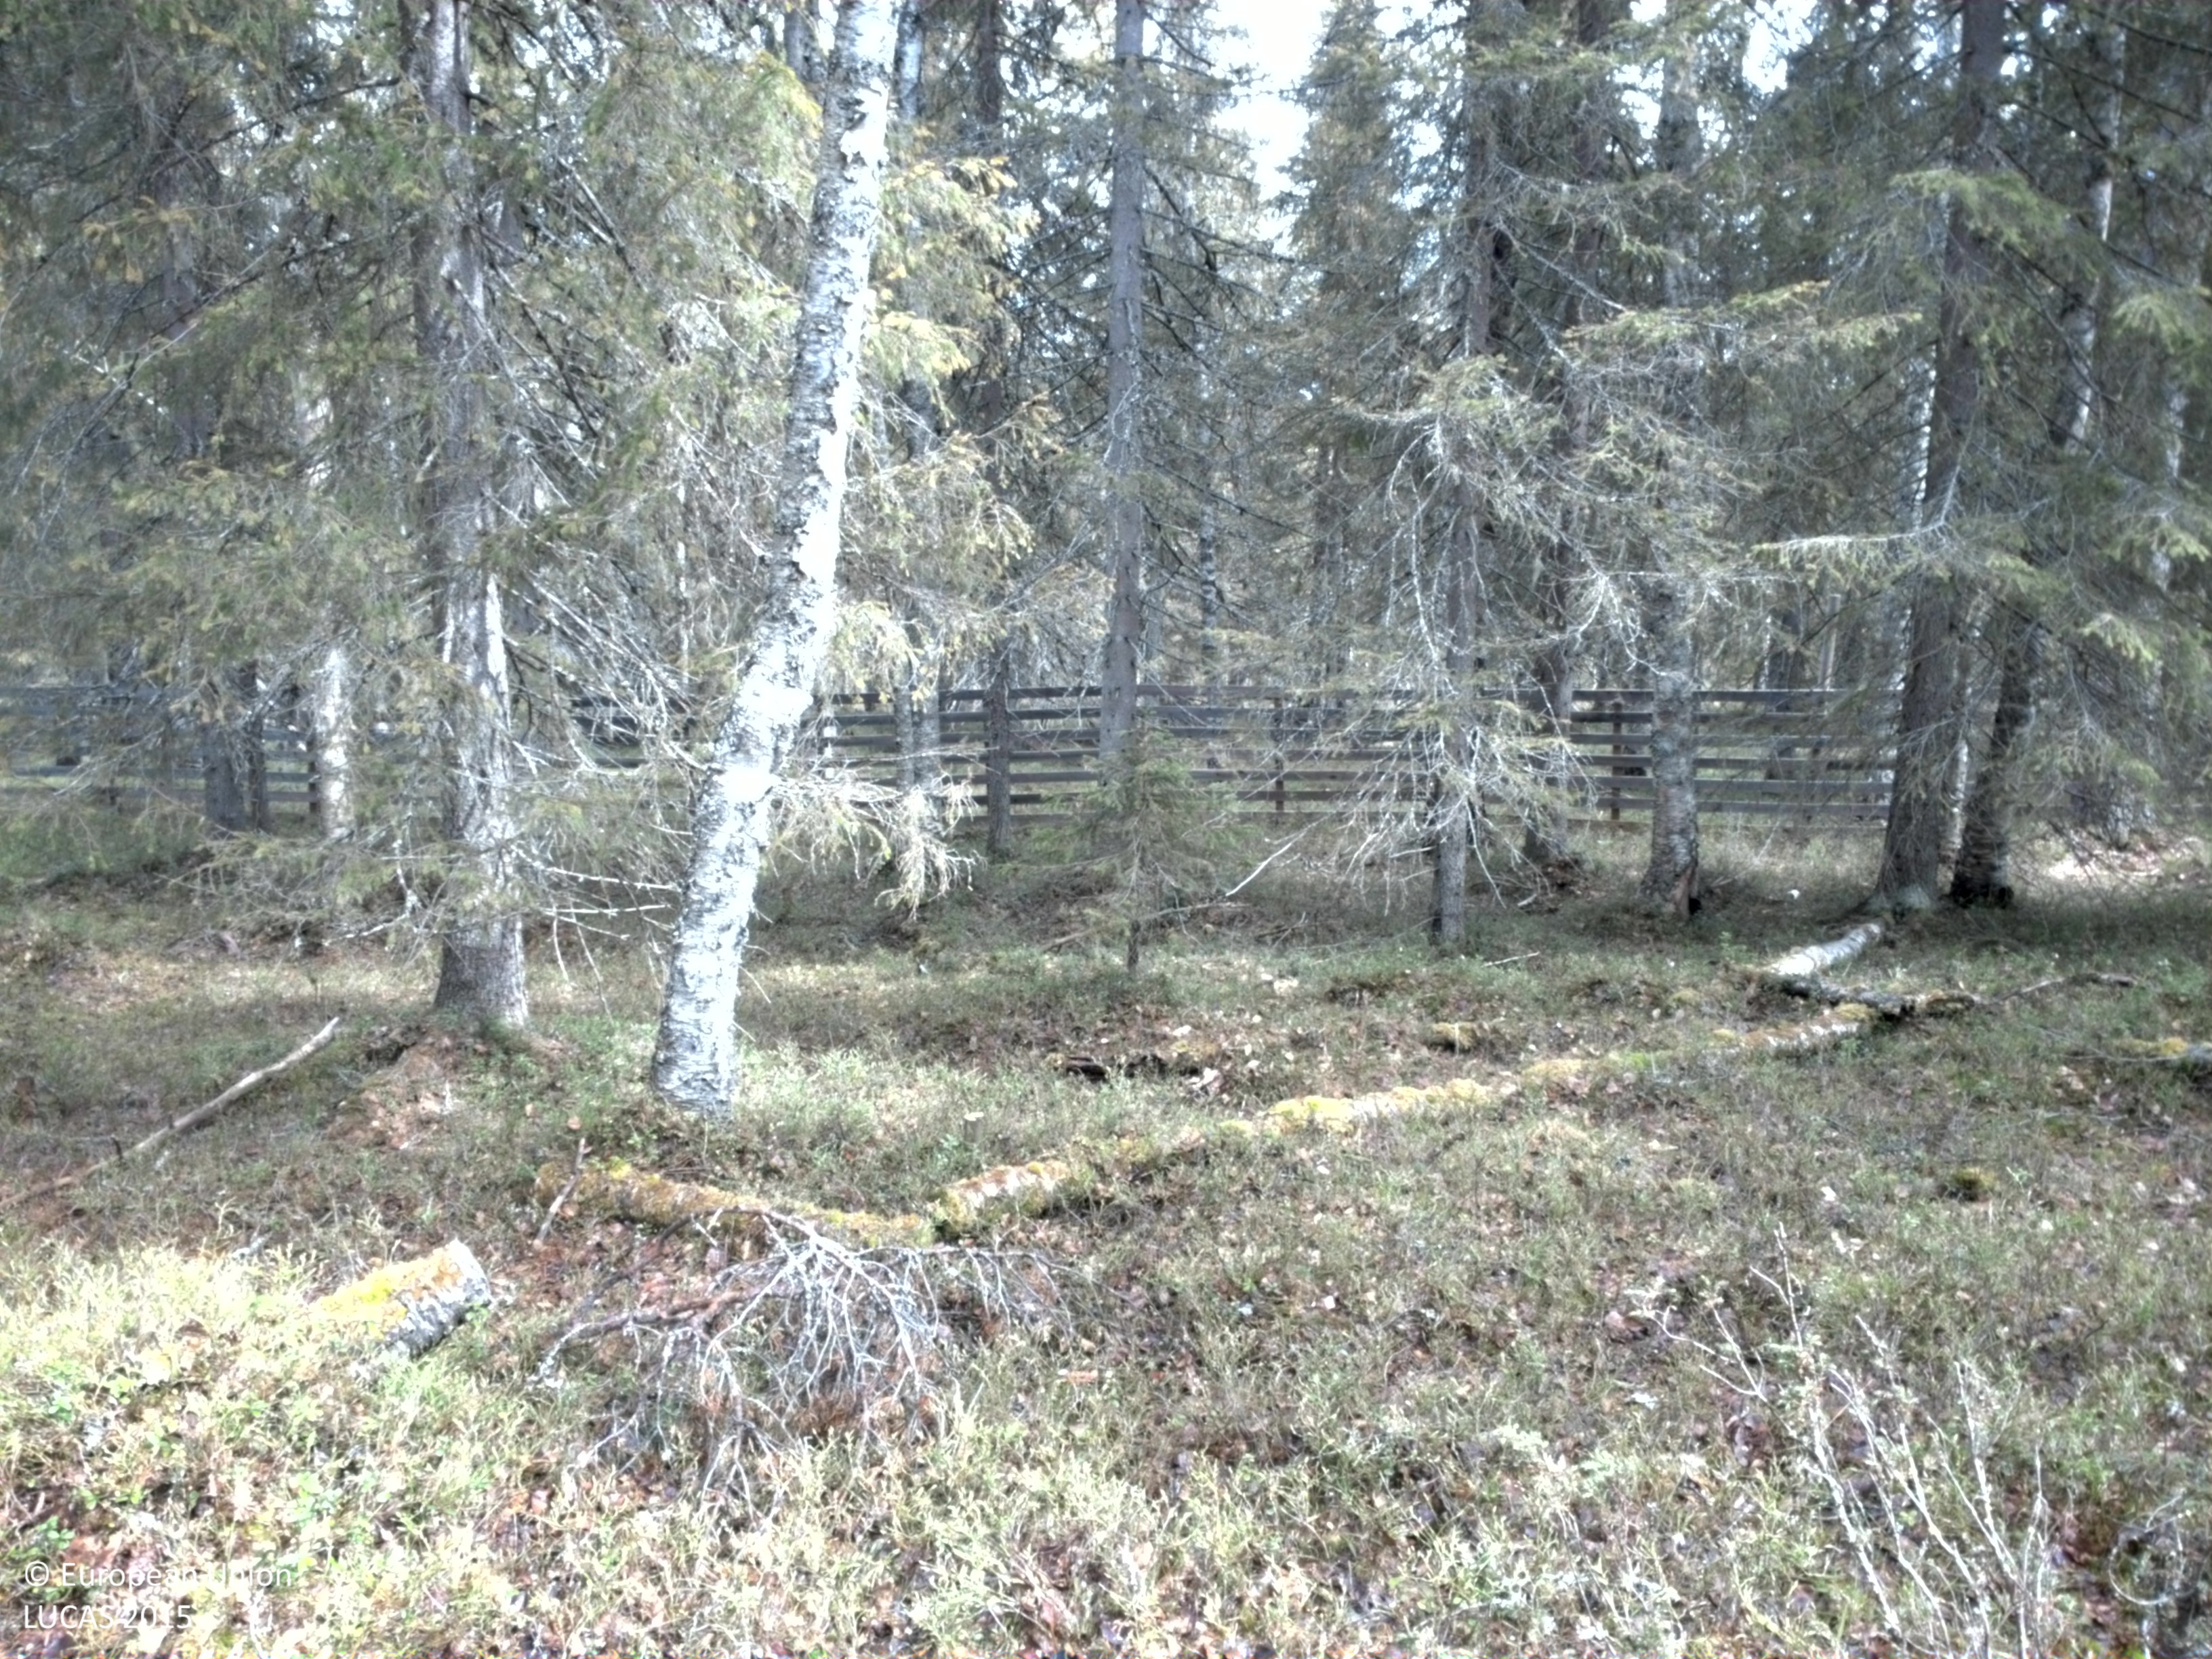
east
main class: Woodland
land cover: Spruce dominated coniferous woodland
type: boreal forest
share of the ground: 50 - 75 %
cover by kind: coniferous forest trees 60 %, shrubs 25 %, broadleaved forest trees 15 %
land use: Forestry
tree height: > 5 m
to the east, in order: Spruce dominated coniferous woodland; Fences; Spruce dominated mixed woodland; Spruce dominated coniferous woodland; Pine dominated coniferous woodland
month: June
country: SE
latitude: 66.4593
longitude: 23.3781
